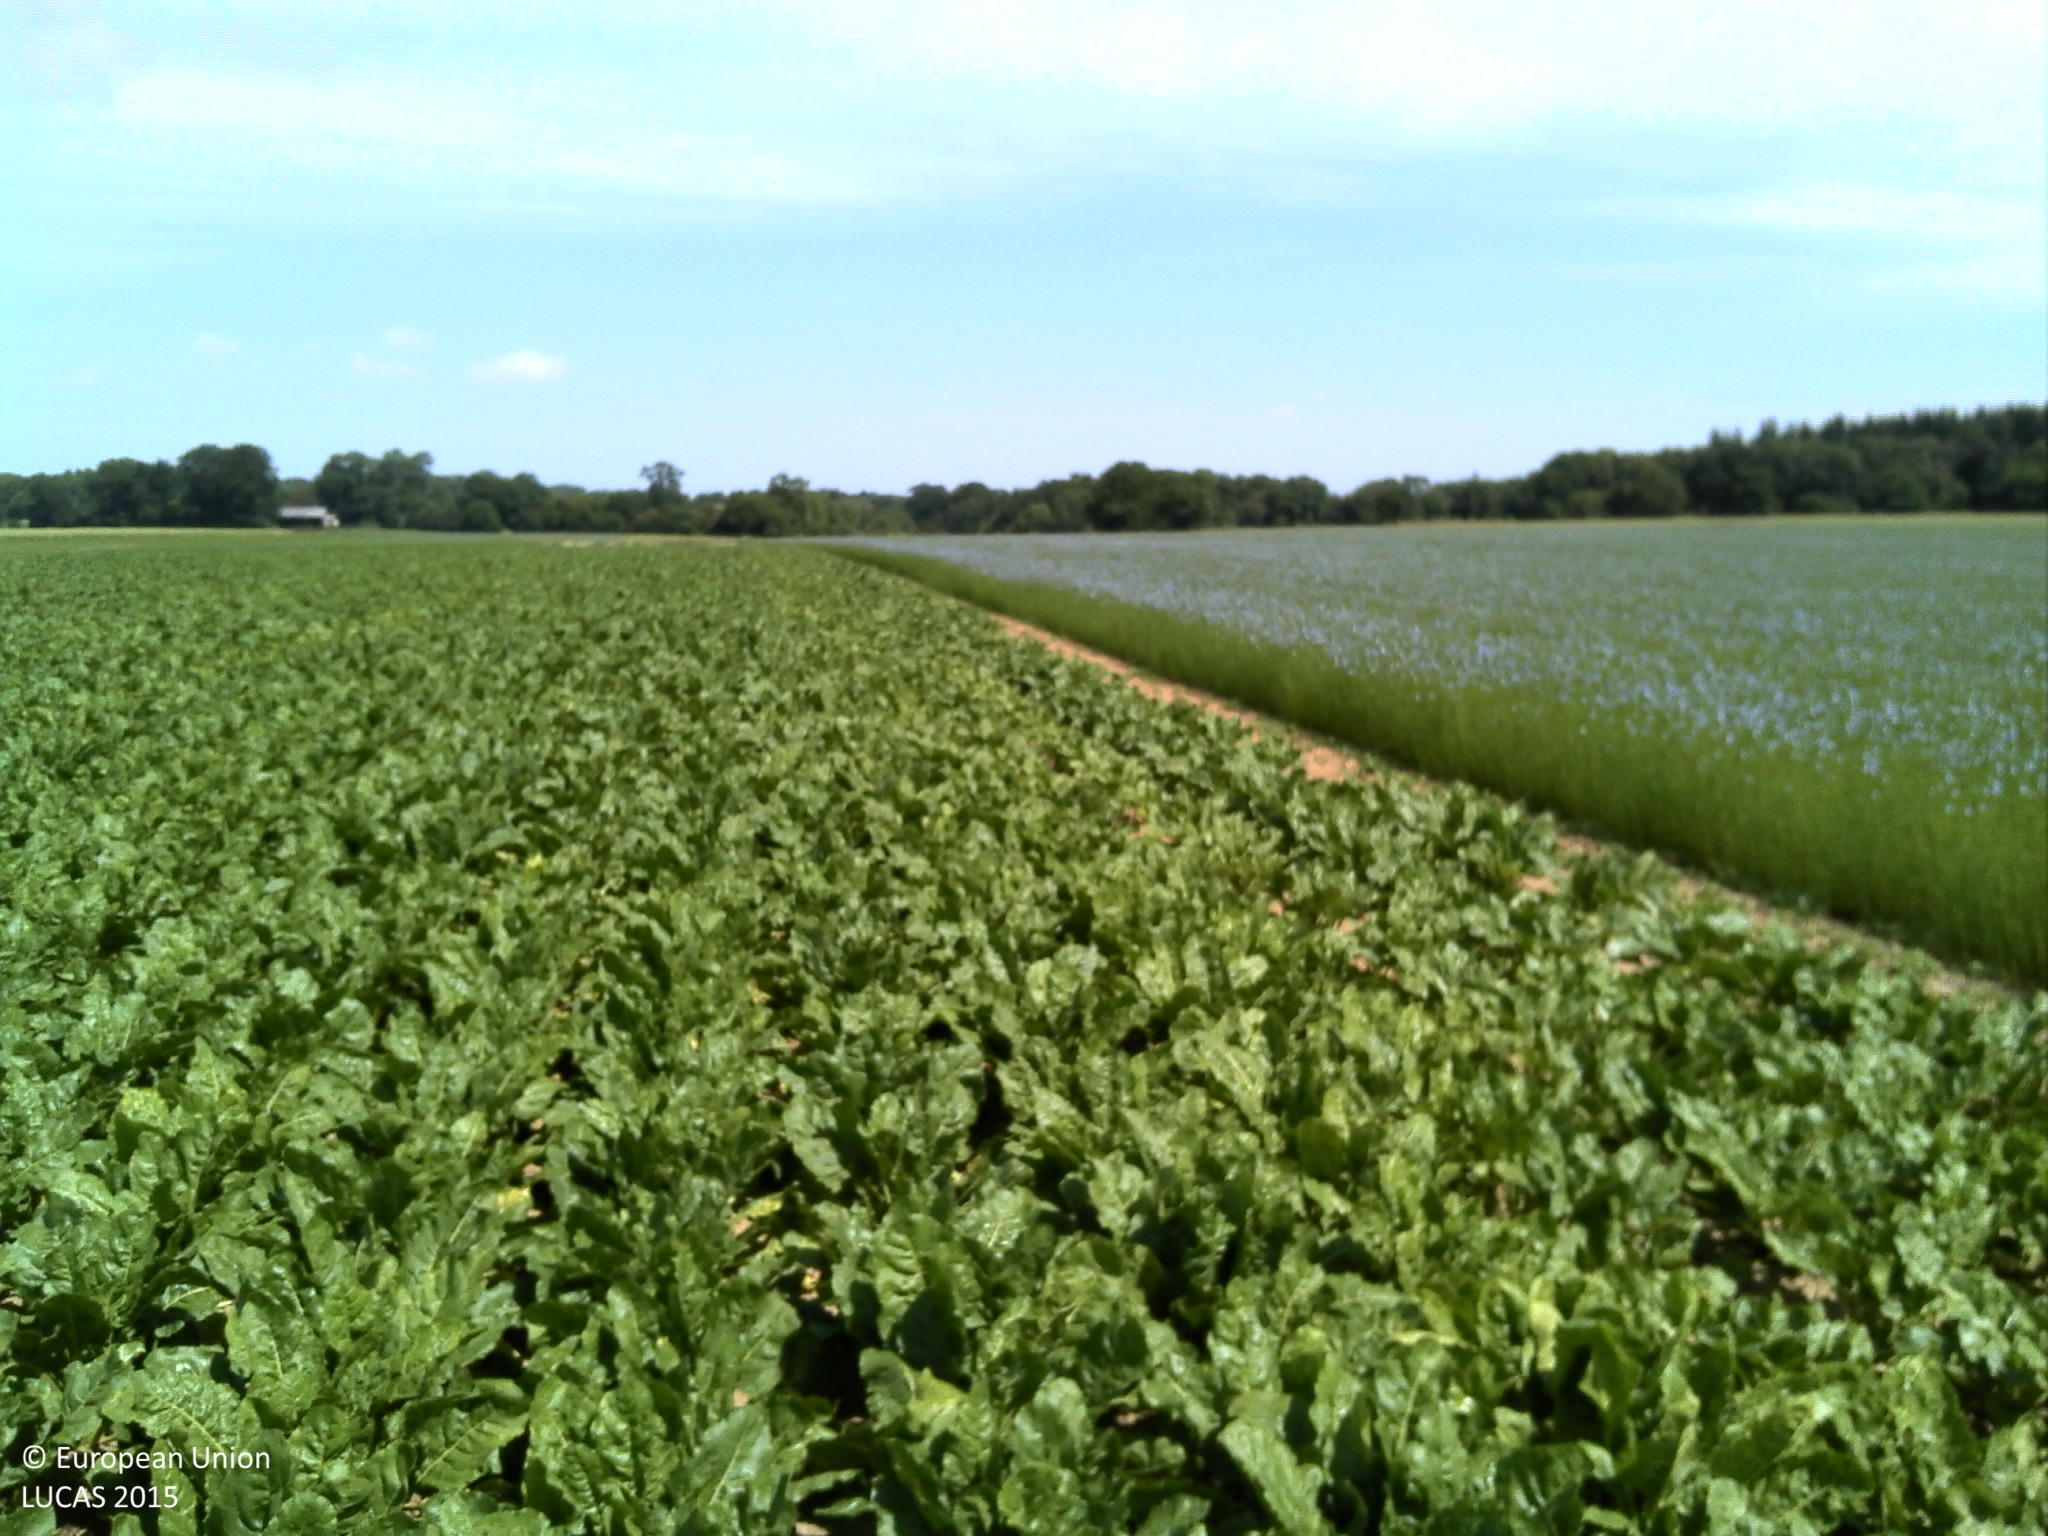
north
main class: Cropland
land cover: Sugar beet
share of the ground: > 75 %
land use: Agriculture (excluding fallow land and kitchen gardens)
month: June
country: FR
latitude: 49.8038
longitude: 1.1556
